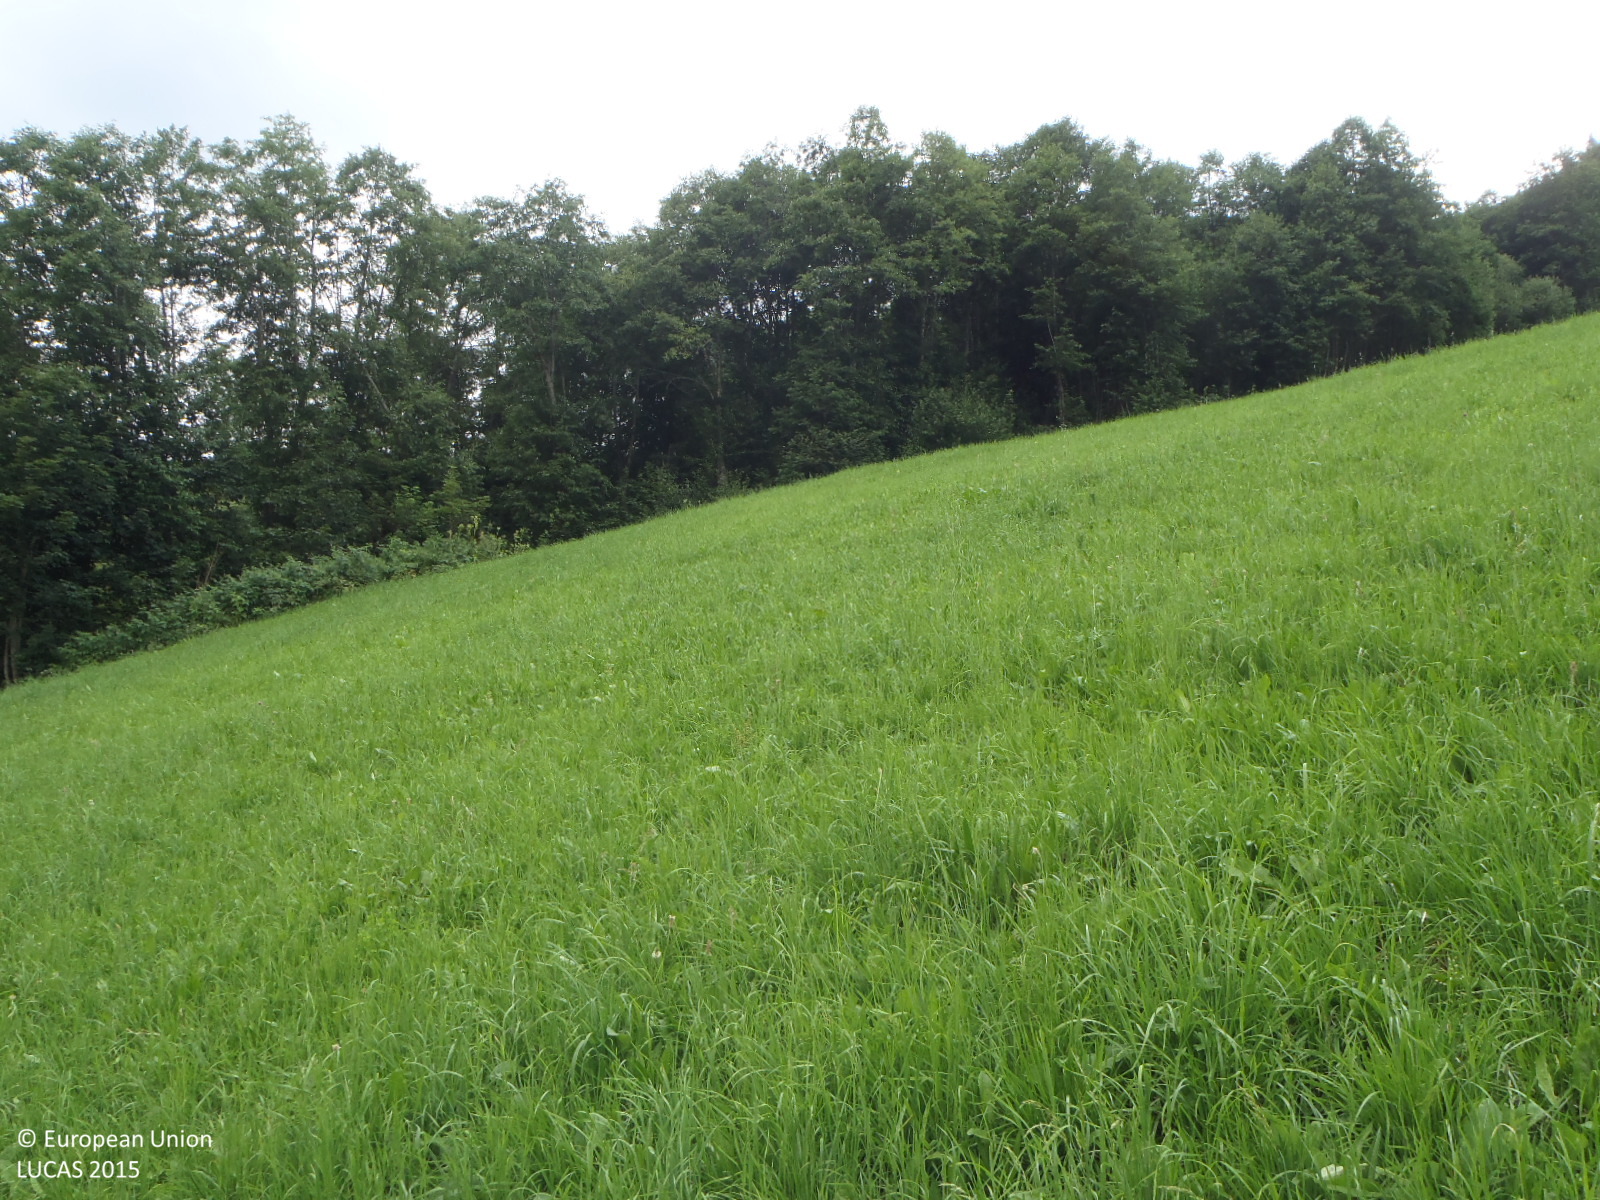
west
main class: Grassland
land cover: Grassland without tree/shrub cover
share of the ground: > 75 %
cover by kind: herbaceous plants 100 %
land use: Agriculture (excluding fallow land and kitchen gardens)
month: July
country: AT
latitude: 47.2323
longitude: 12.0456
